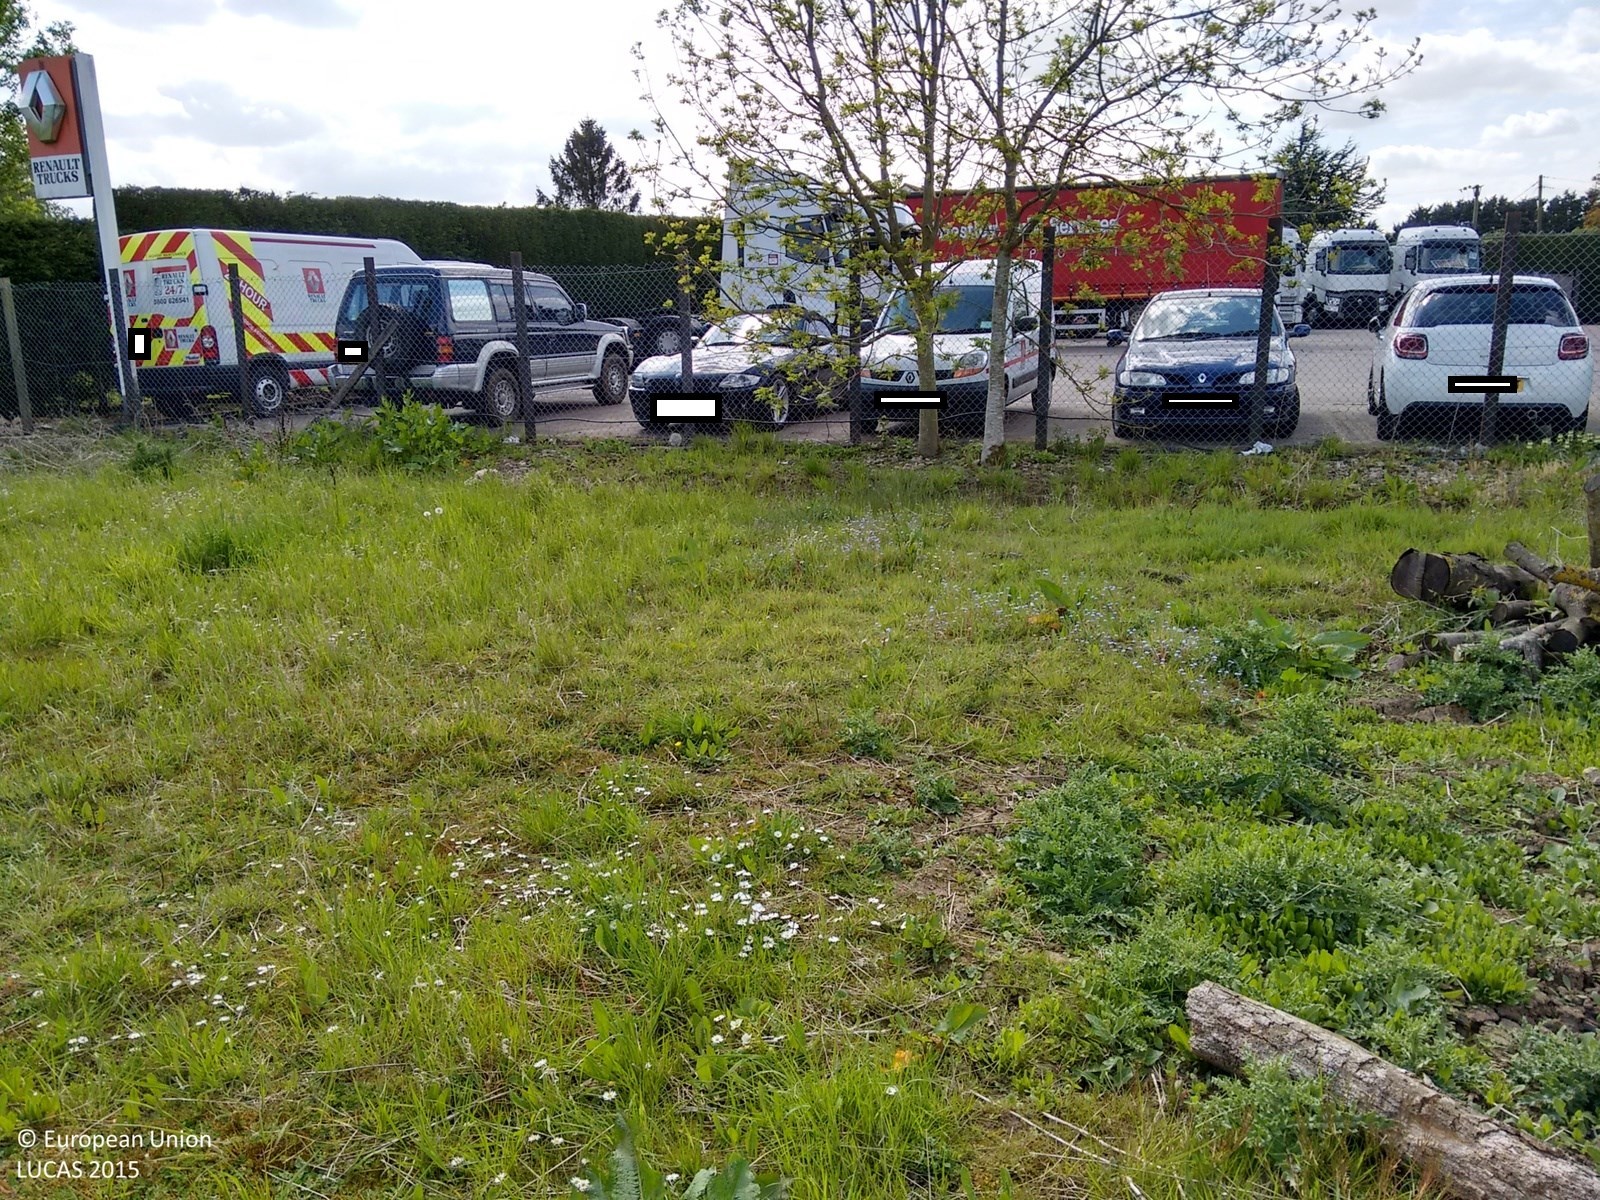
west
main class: Grassland
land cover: Grassland without tree/shrub cover
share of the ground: > 75 %
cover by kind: herbaceous plants 100 %
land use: Agriculture (excluding fallow land and kitchen gardens)
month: May
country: GB
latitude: 52.9570
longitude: -0.1412
